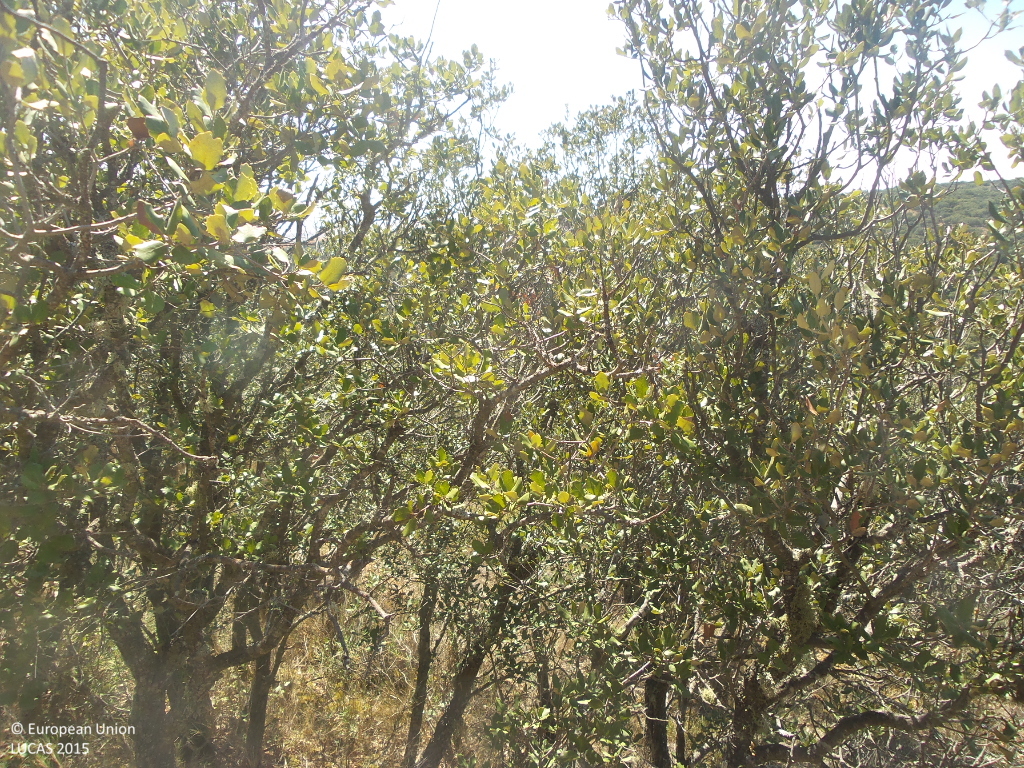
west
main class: Woodland
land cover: Broadleaved woodland
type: broadleaved evergreen forest
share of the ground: 50 - 75 %
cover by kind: broadleaved forest trees 70 %, shrubs 10 %, unconsolidated bare surface 10 %, herbaceous plants 5 %, lichens and mosses 5 %
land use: Semi-natural and natural areas not in use
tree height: < 5 m
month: July
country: ES
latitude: 41.3641
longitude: -2.0677
